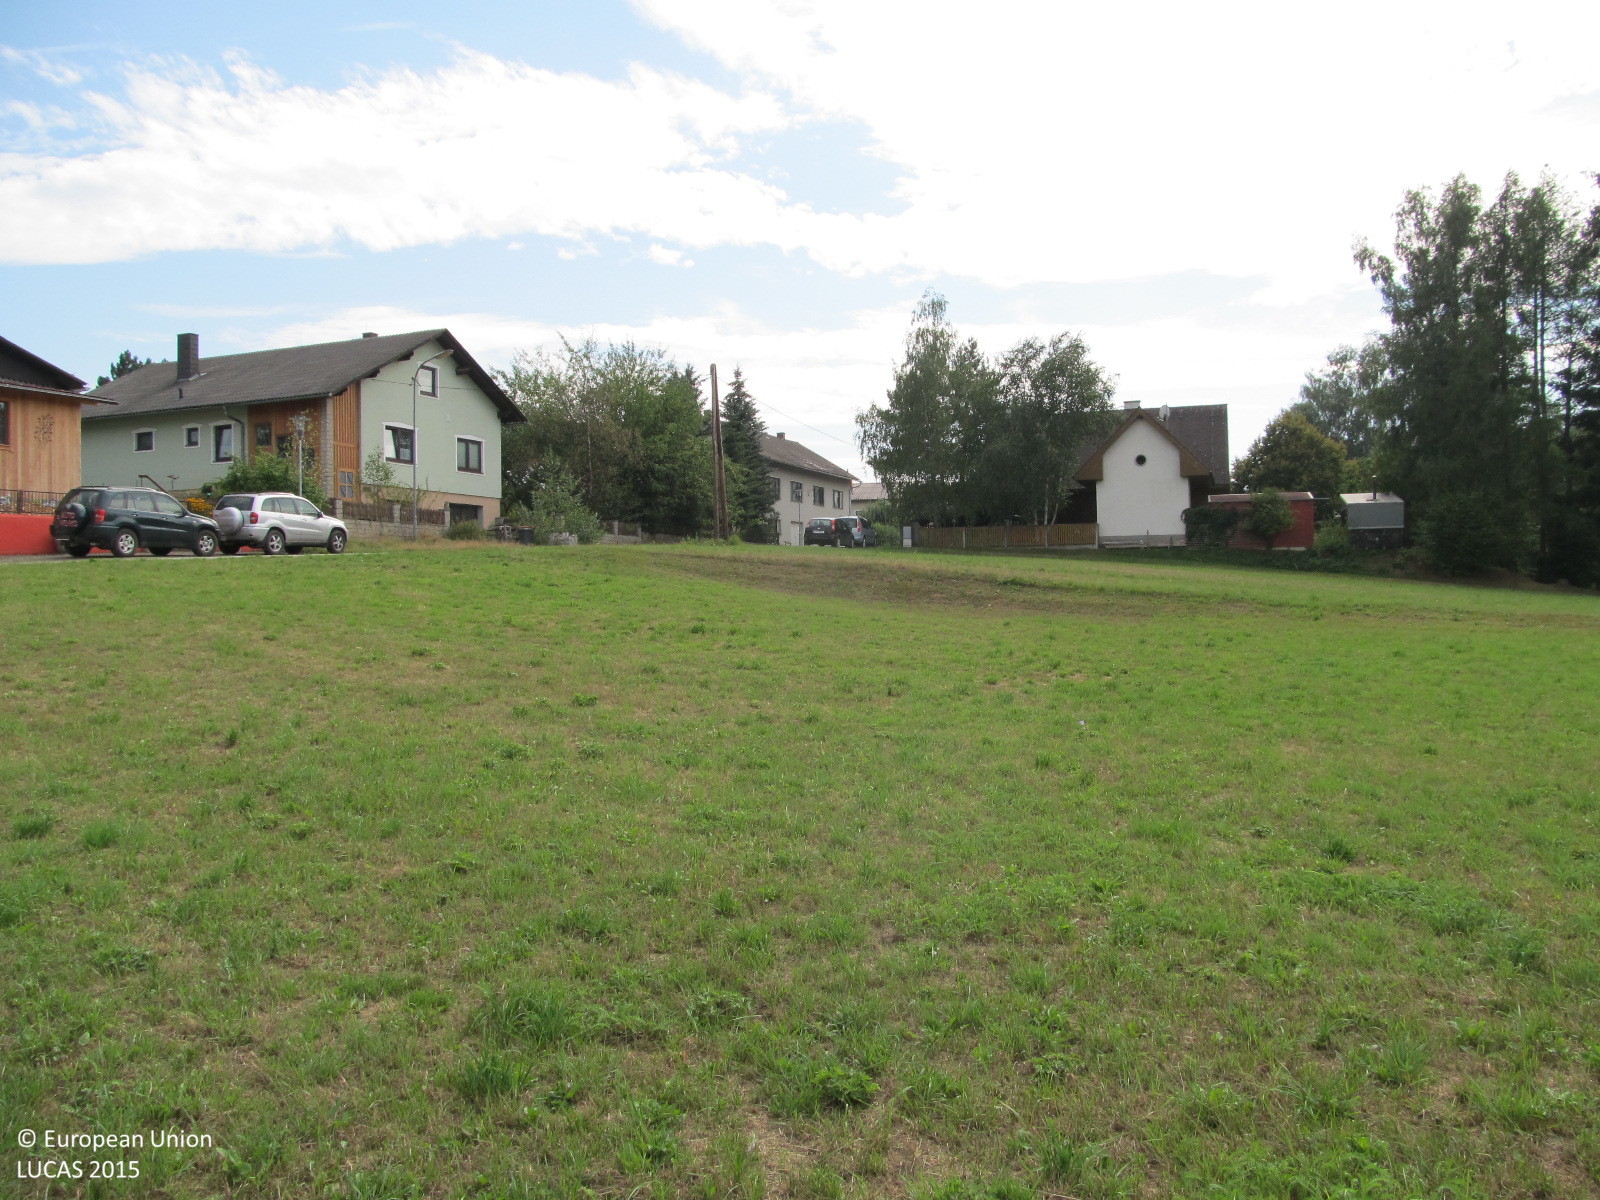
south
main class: Grassland
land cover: Grassland without tree/shrub cover
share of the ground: > 75 %
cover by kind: herbaceous plants 100 %
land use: Agriculture (excluding fallow land and kitchen gardens)
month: August
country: AT
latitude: 48.9170
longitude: 15.4753
